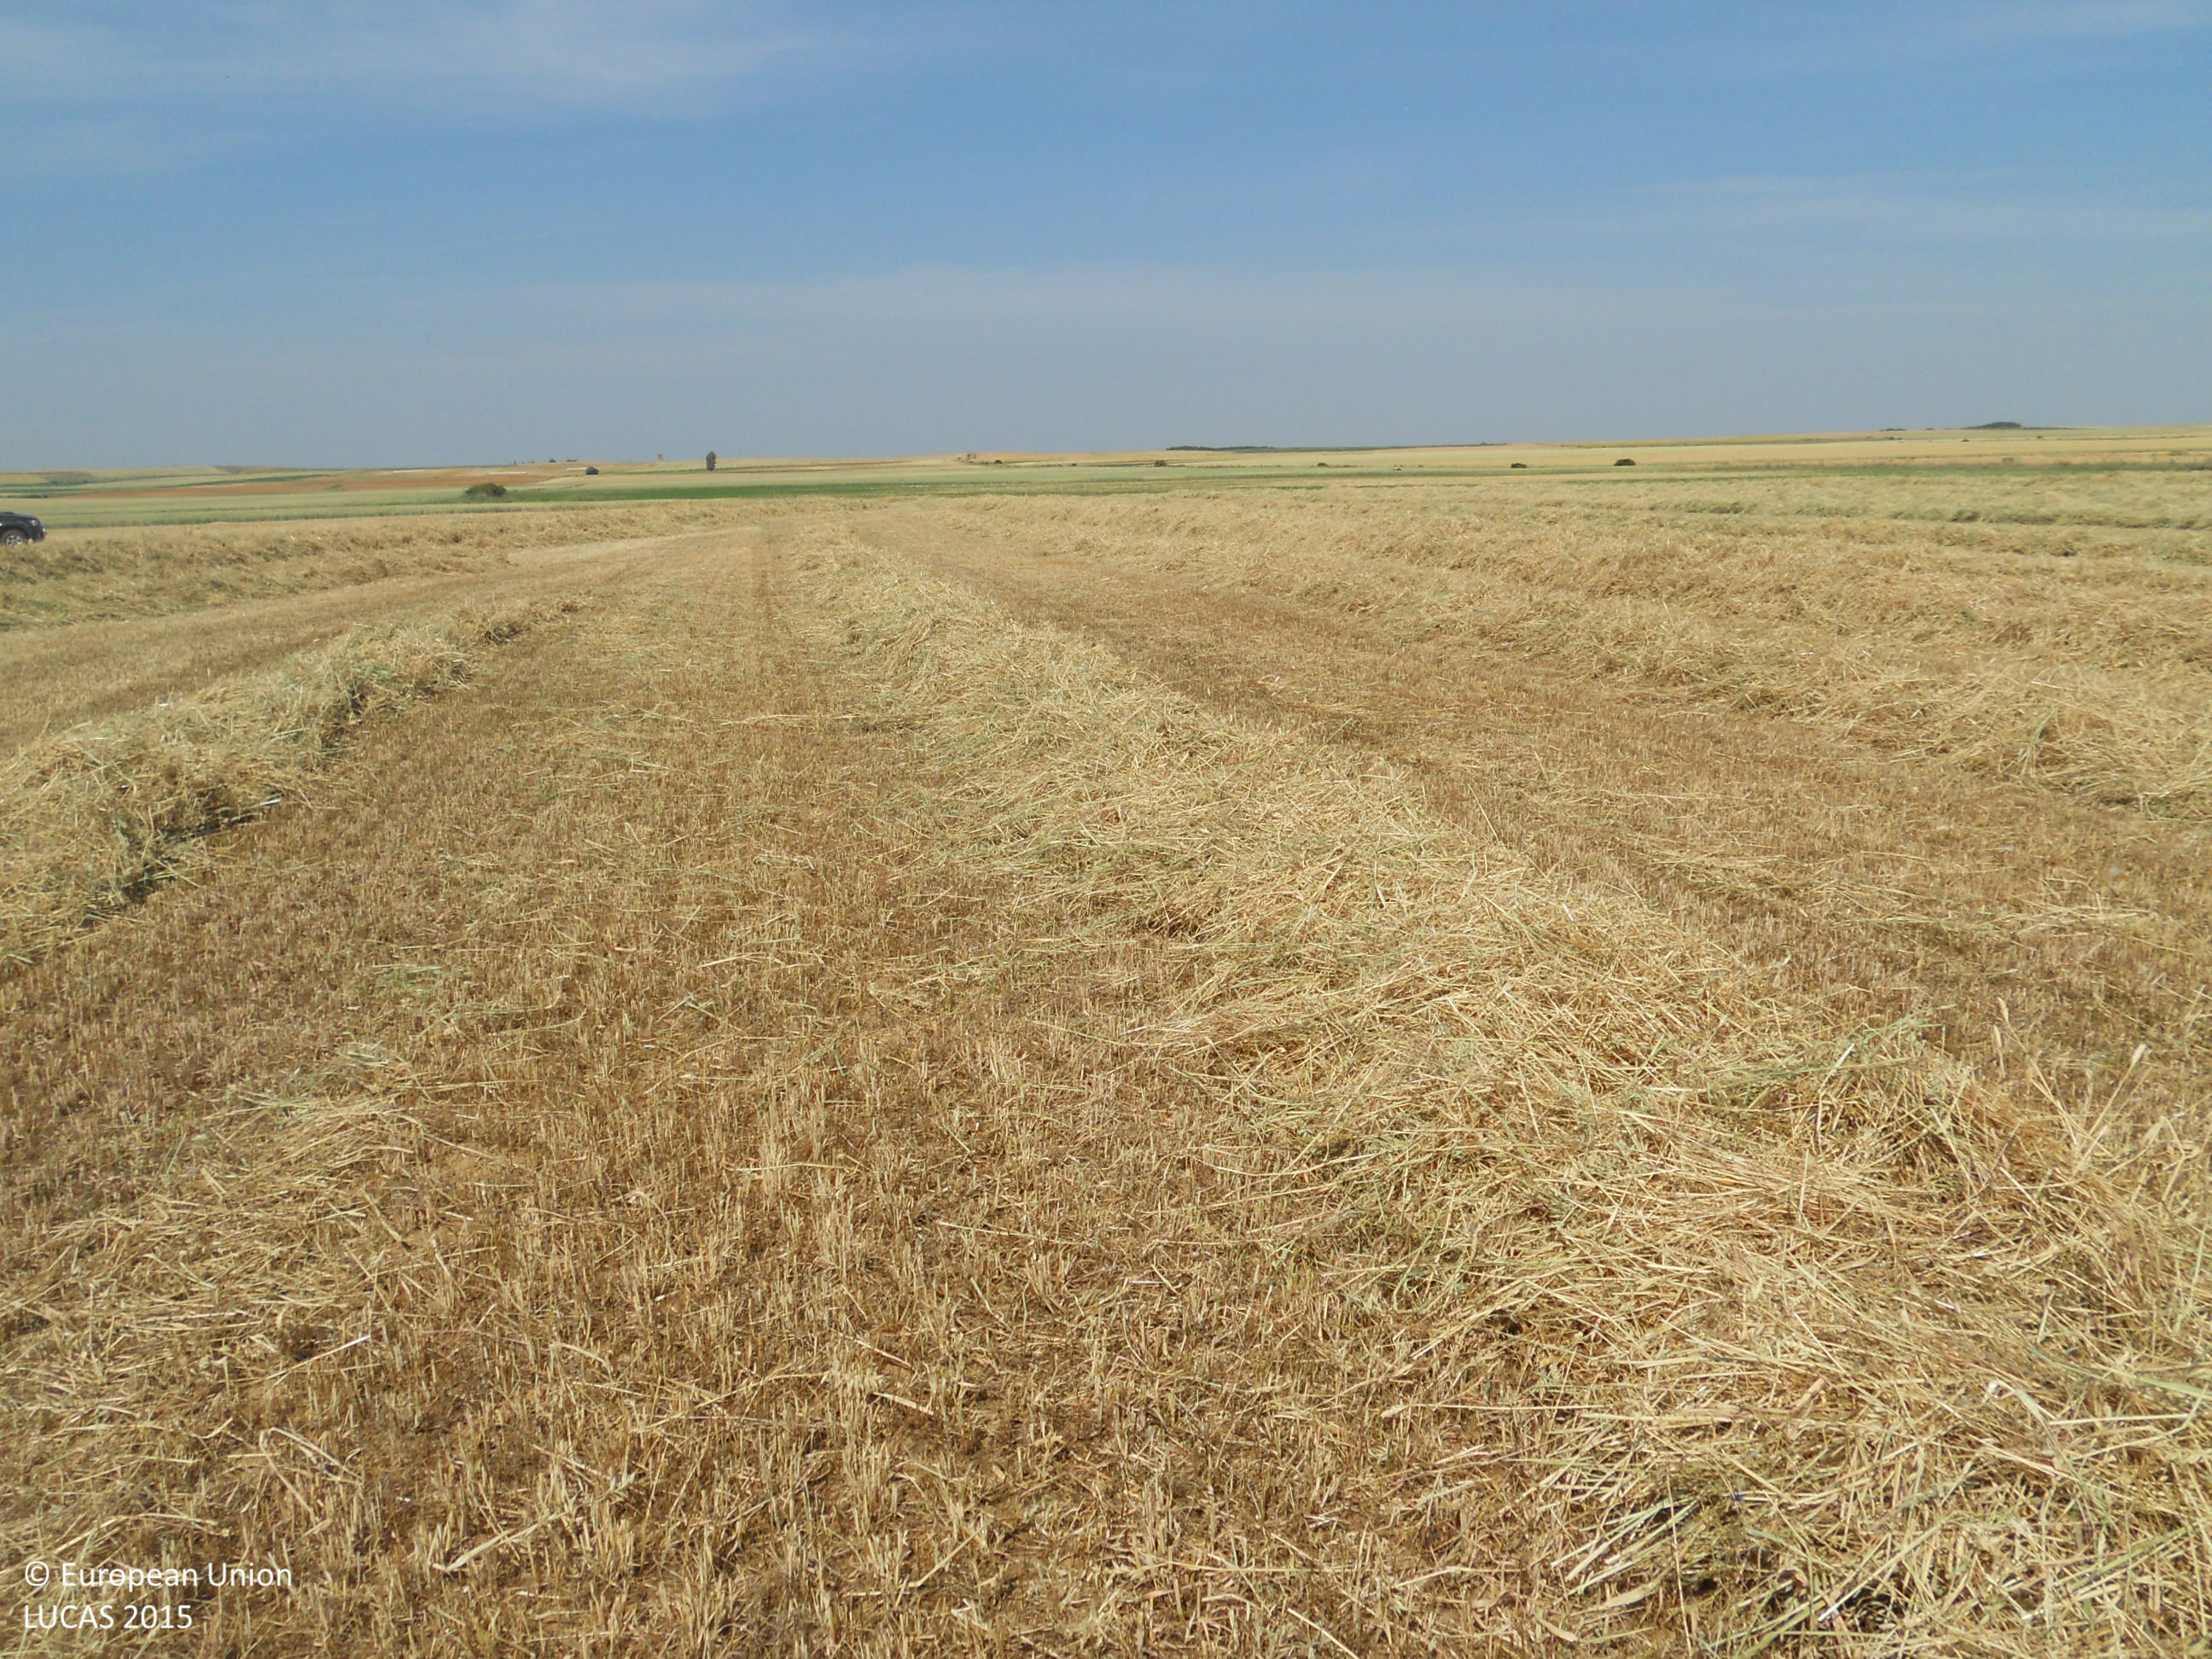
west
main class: Cropland
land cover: Mixed cereals for fodder
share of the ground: < 10 %
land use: Agriculture (excluding fallow land and kitchen gardens)
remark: Harvested field
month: June
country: ES
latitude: 42.3565
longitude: -5.3506
